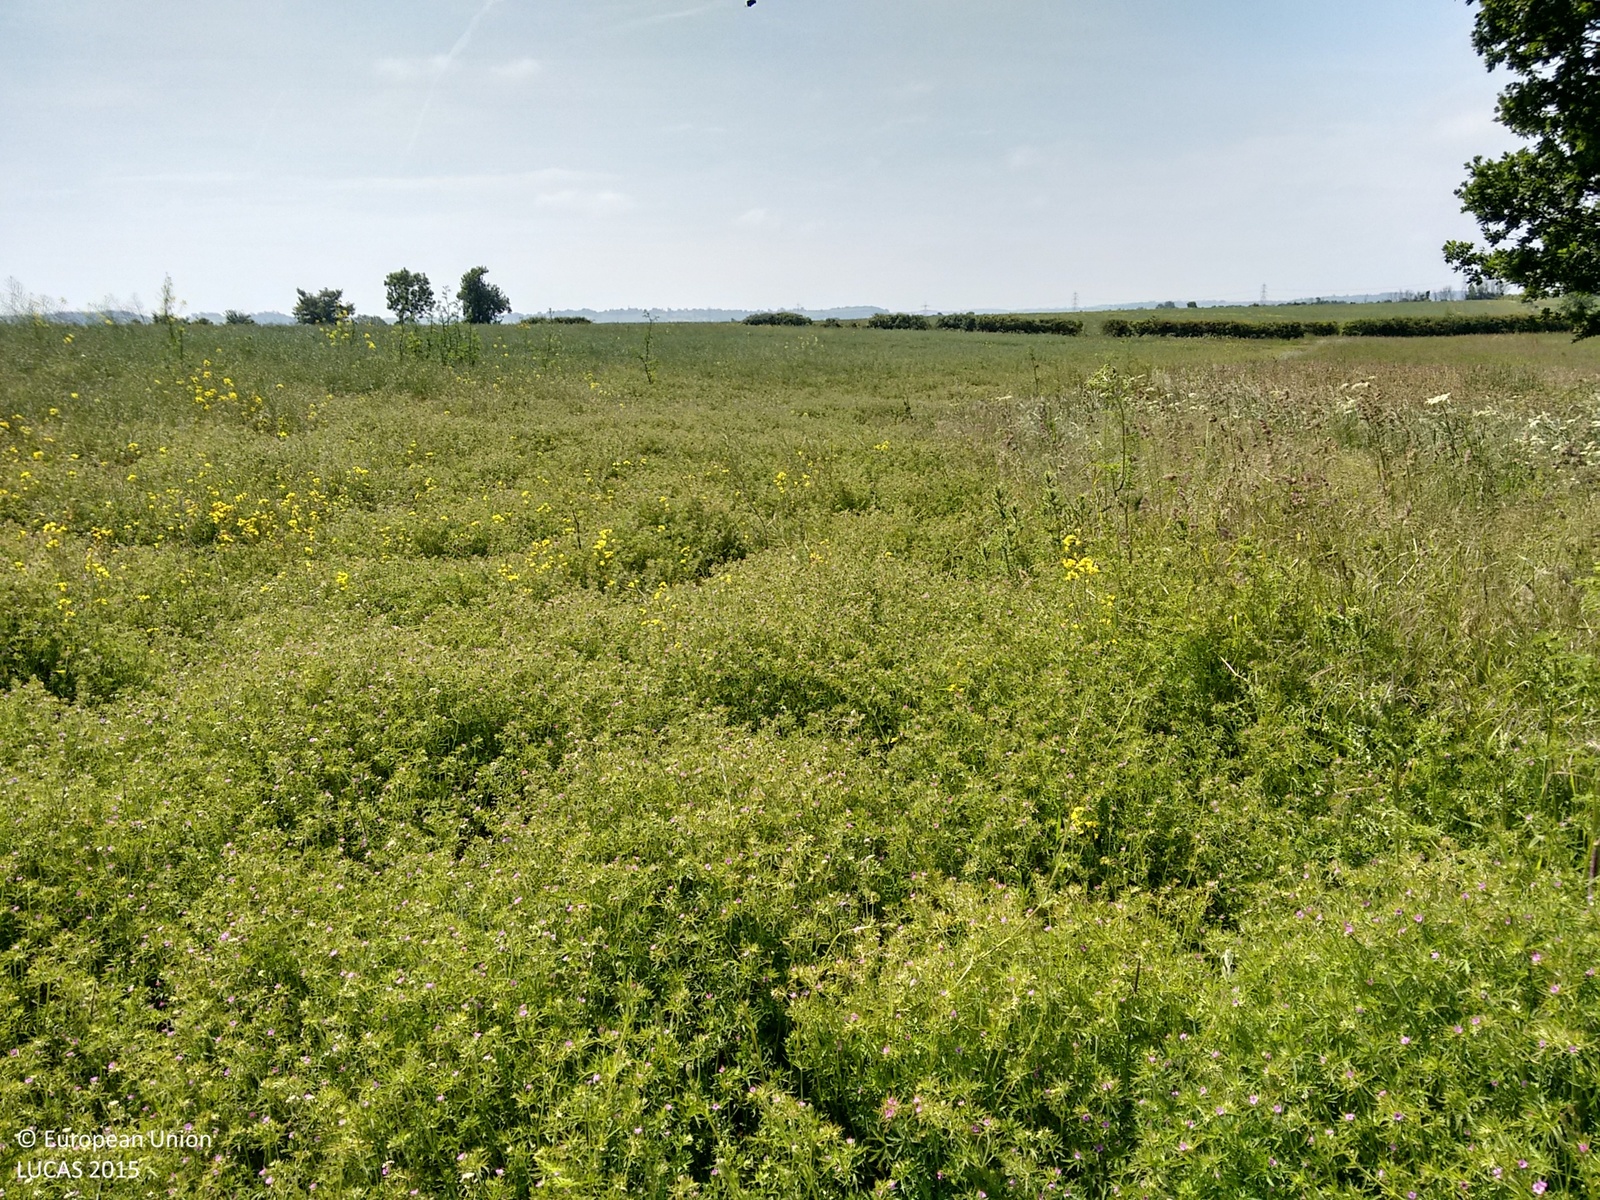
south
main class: Grassland
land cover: Spontaneously vegetated surfaces
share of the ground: > 75 %
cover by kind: herbaceous plants 100 %
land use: Agriculture (excluding fallow land and kitchen gardens)
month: June
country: GB
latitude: 52.9614
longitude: -0.7145
